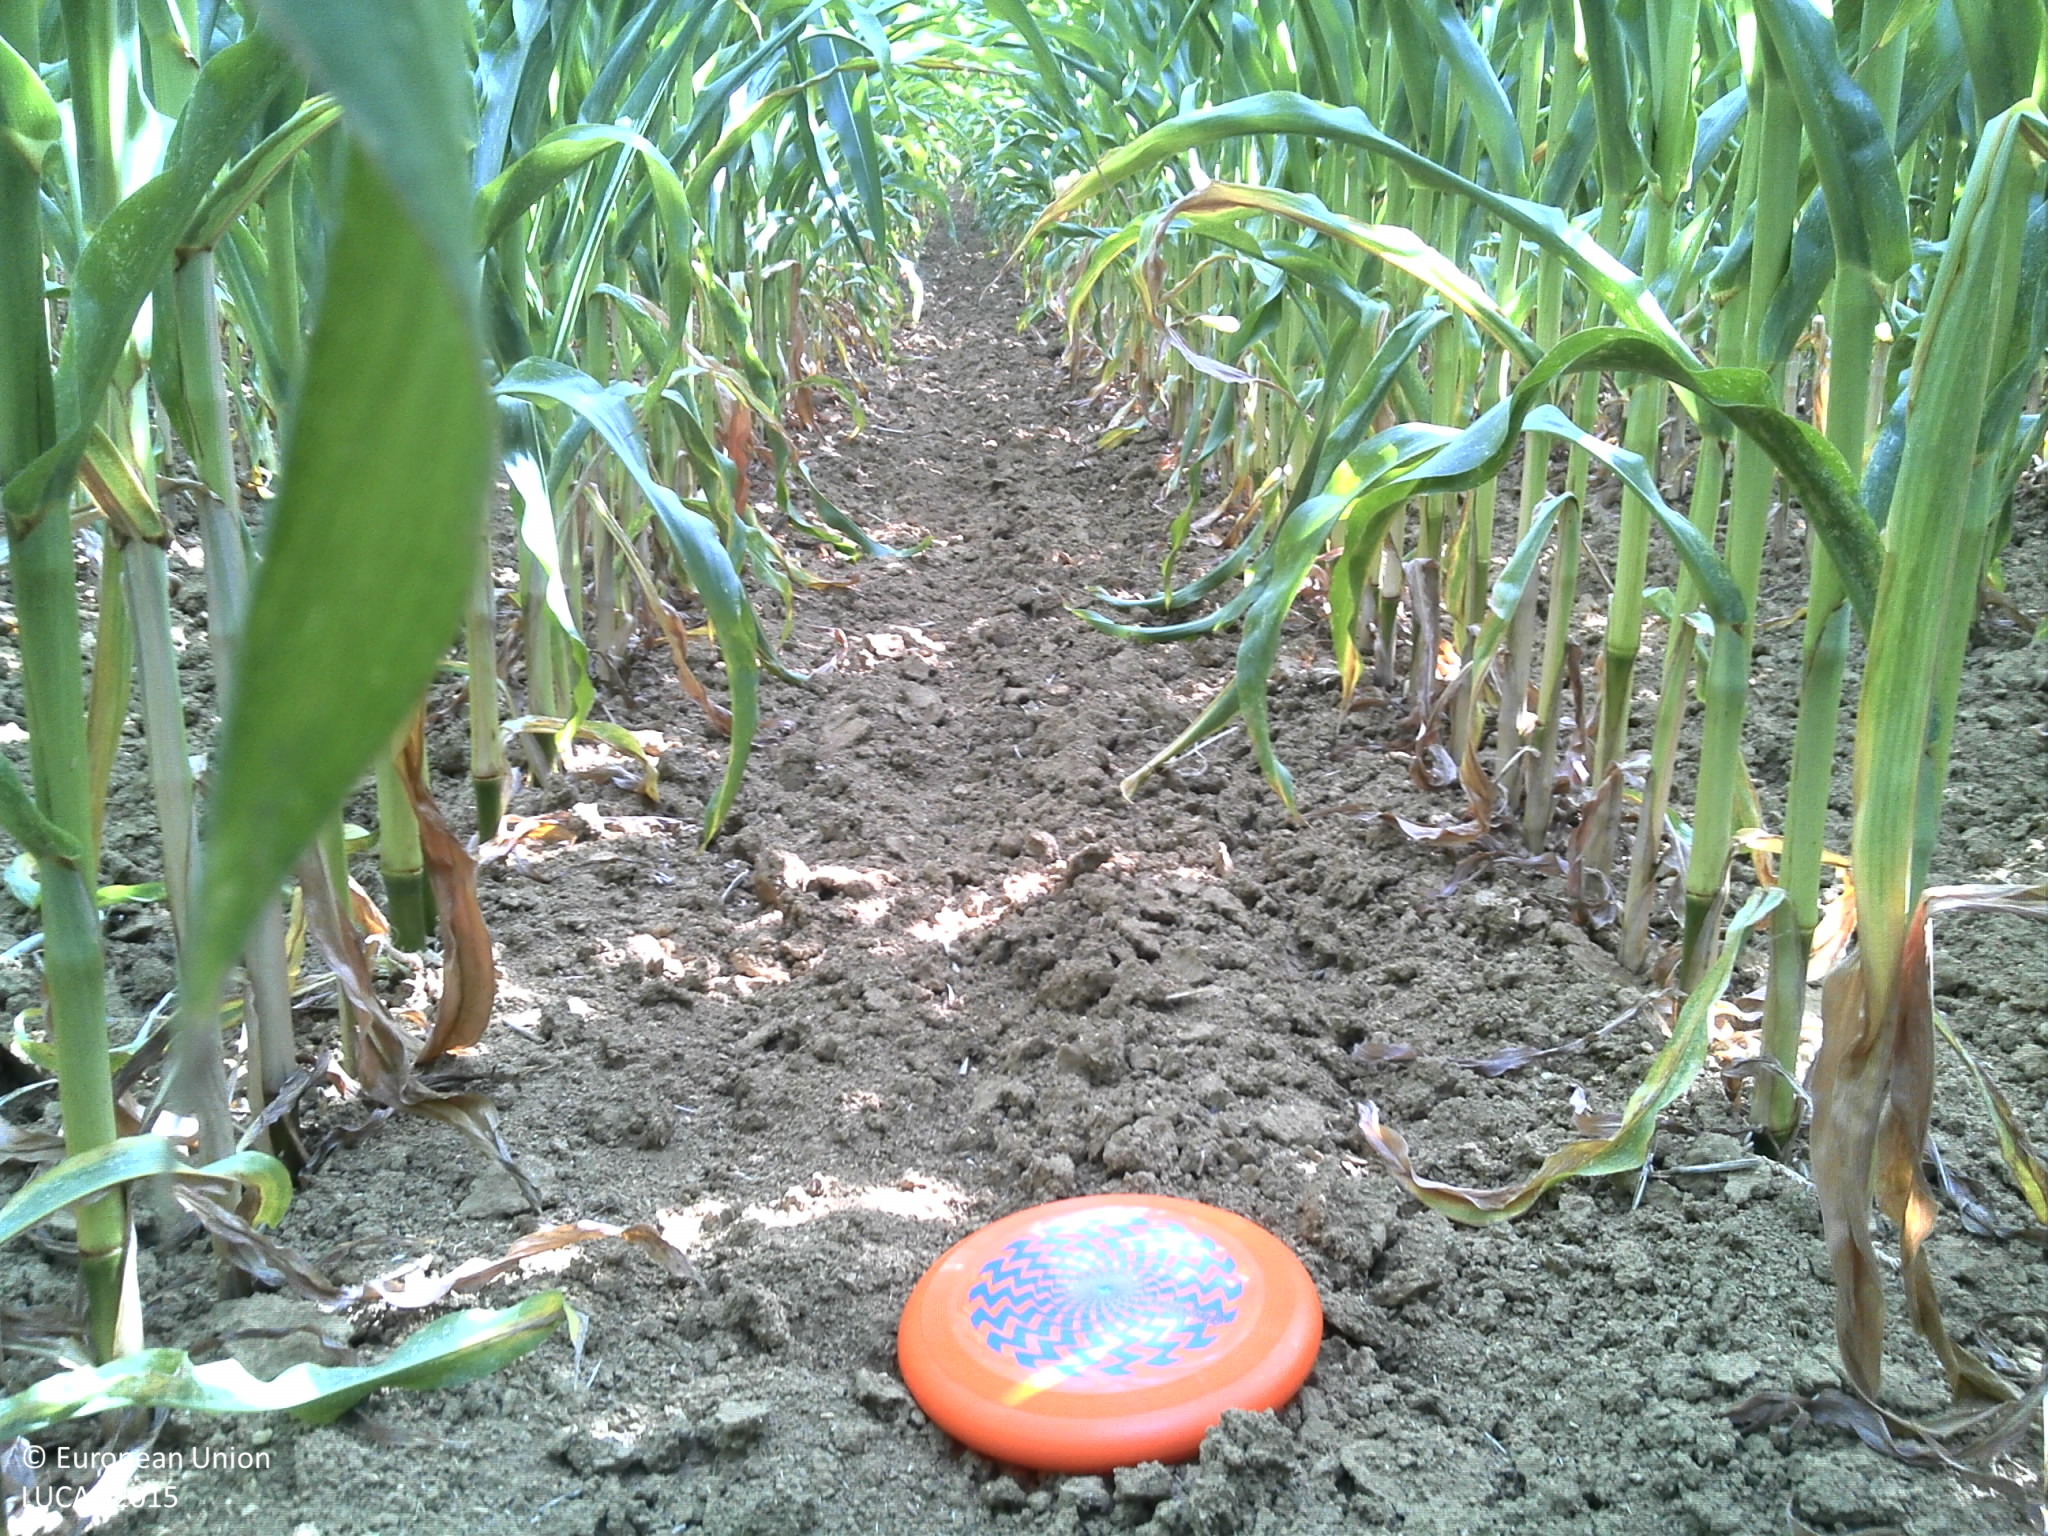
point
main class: Cropland
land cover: Maize
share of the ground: 25 - 50 %
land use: Agriculture (excluding fallow land and kitchen gardens)
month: August
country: FR
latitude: 48.9864
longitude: 4.8458
